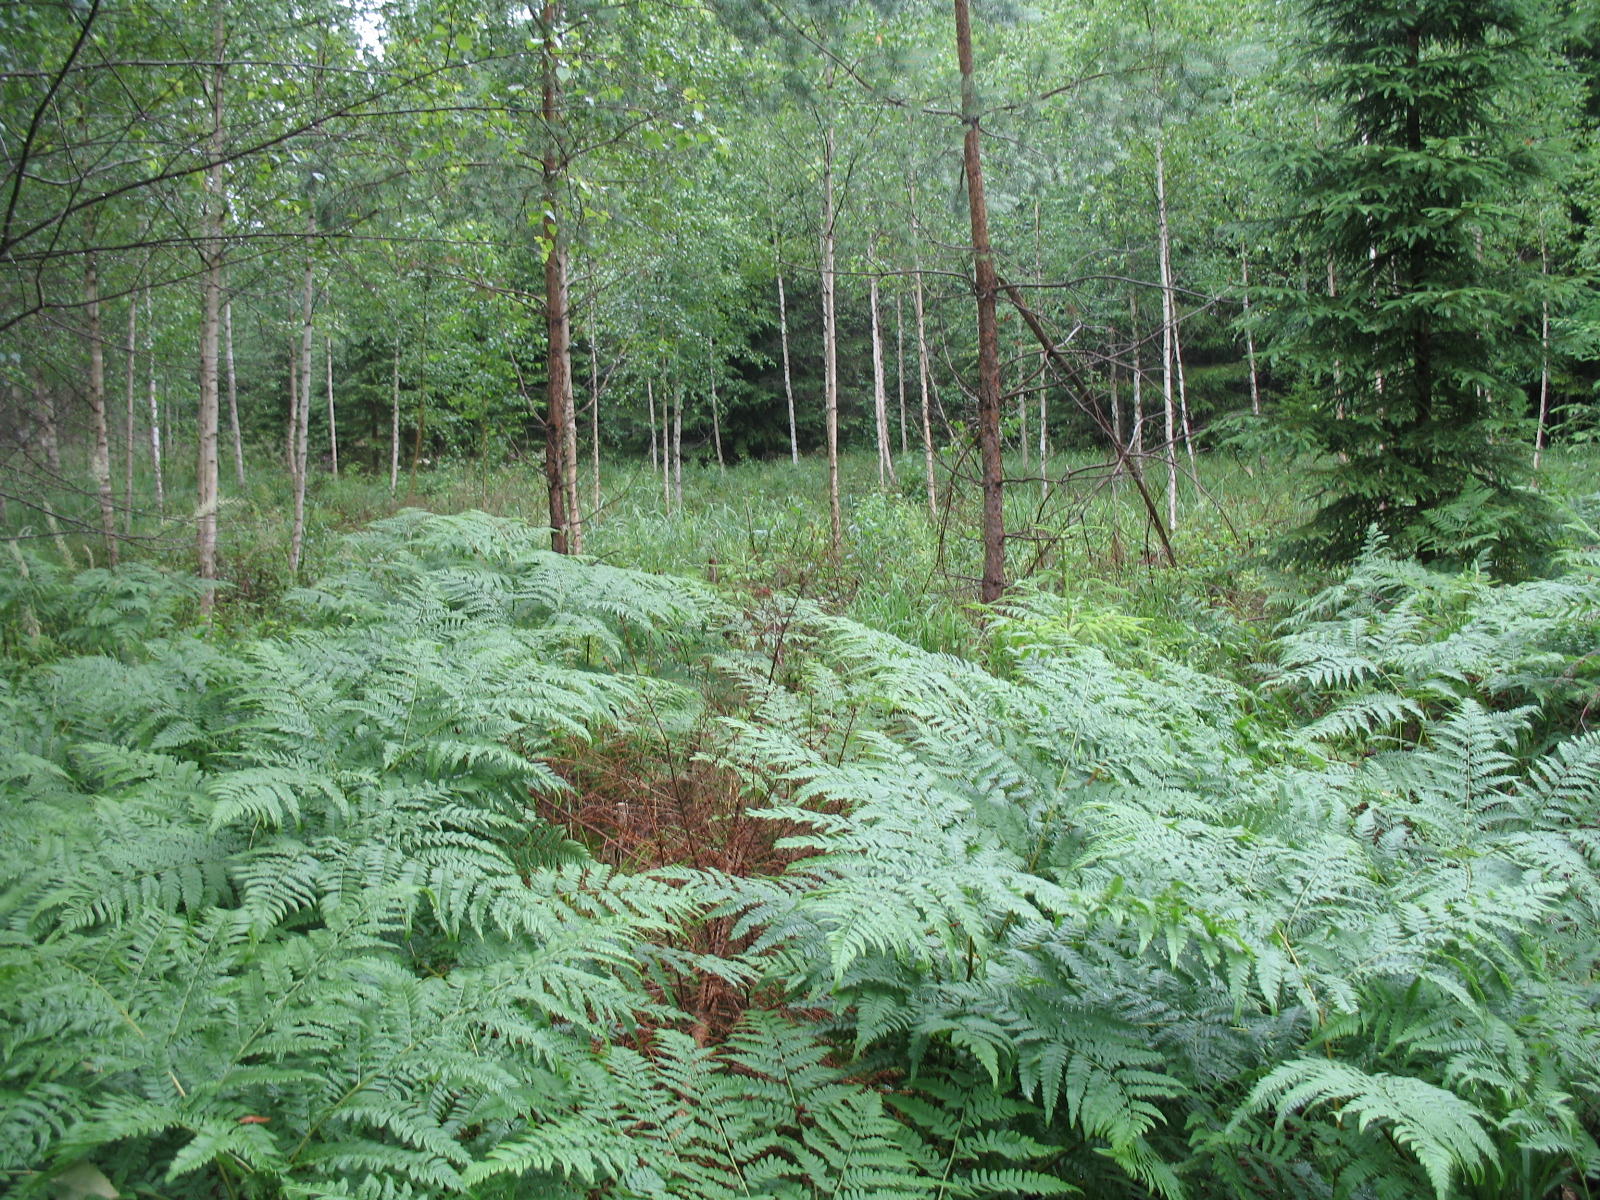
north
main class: Woodland
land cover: Spruce dominated mixed woodland
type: hemiboreal forest and nemoral coniferous forest and mixed broadleaved-coniferous forest
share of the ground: 50 - 75 %
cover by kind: broadleaved forest trees 40 %, herbaceous plants 40 %, coniferous forest trees 20 %
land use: Forestry
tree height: > 5 m
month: July
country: LV
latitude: 56.7354
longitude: 23.7948
